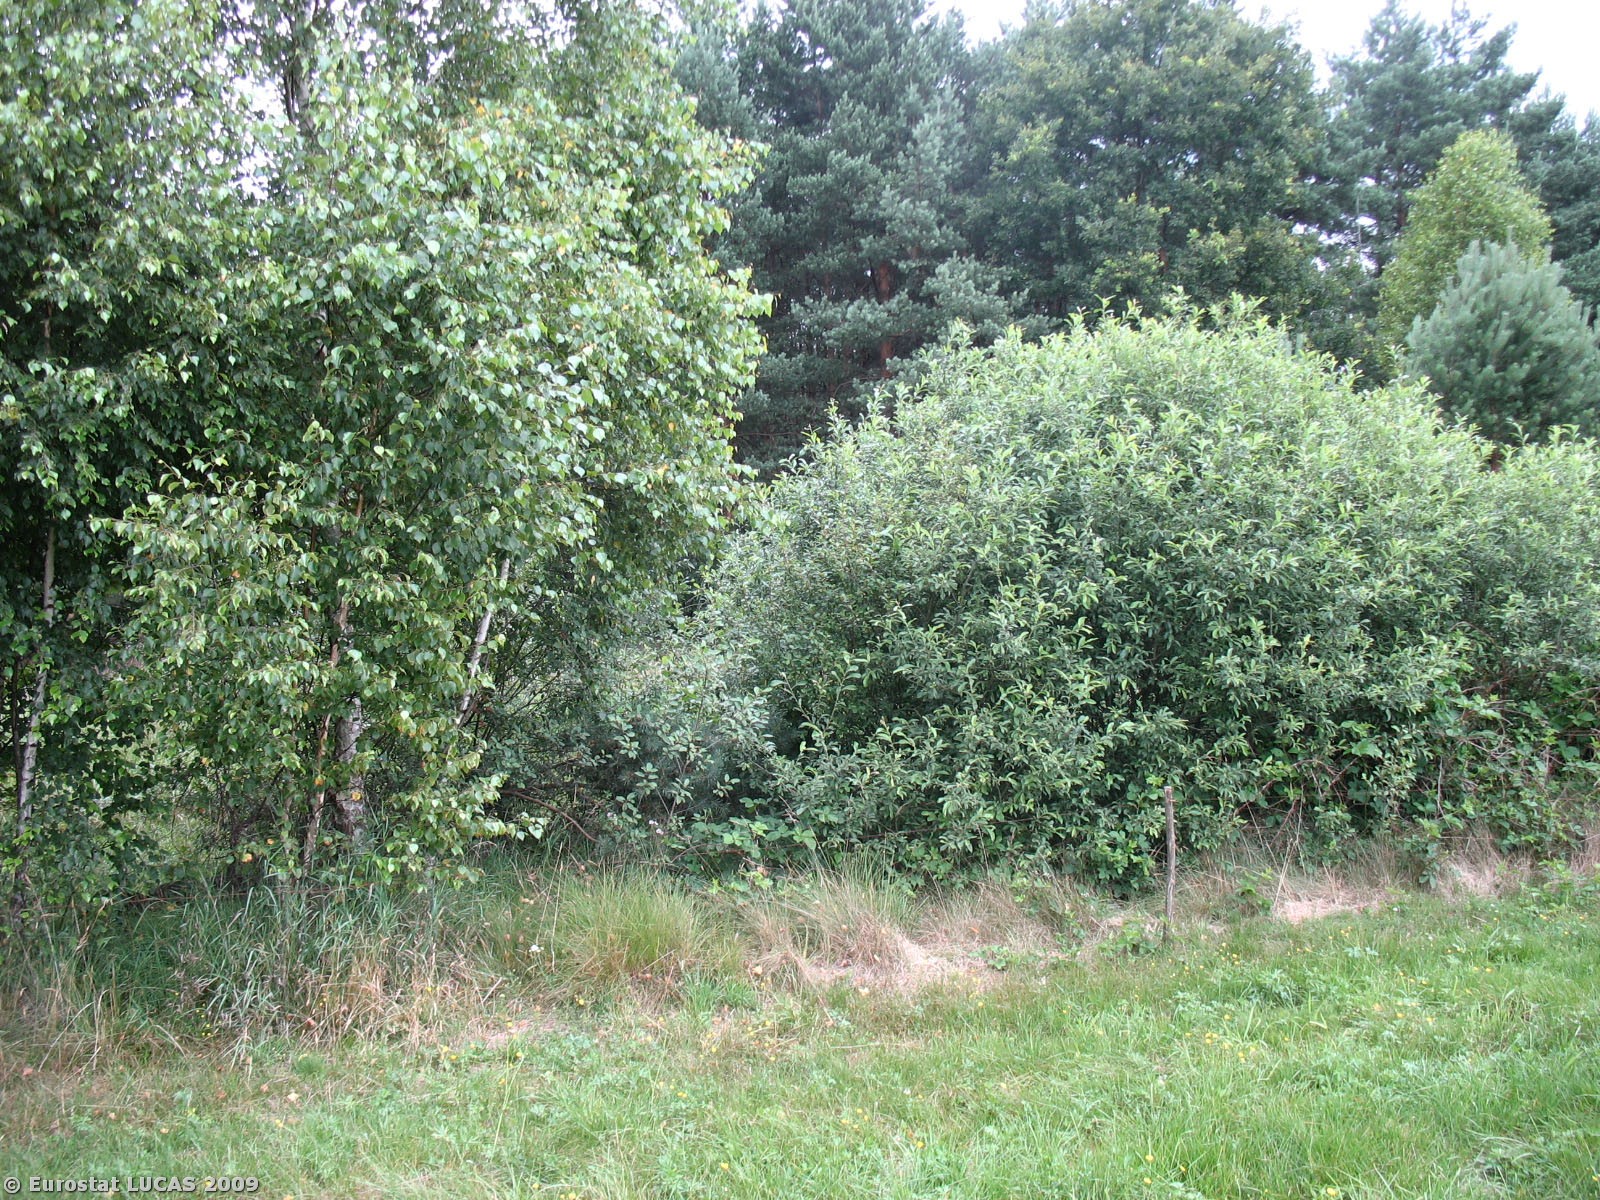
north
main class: Grassland
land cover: Grassland without tree/shrub cover
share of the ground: > 75 %
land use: Agriculture (excluding fallow land and kitchen gardens)
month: July
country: PL
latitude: 50.8418
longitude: 19.8729
